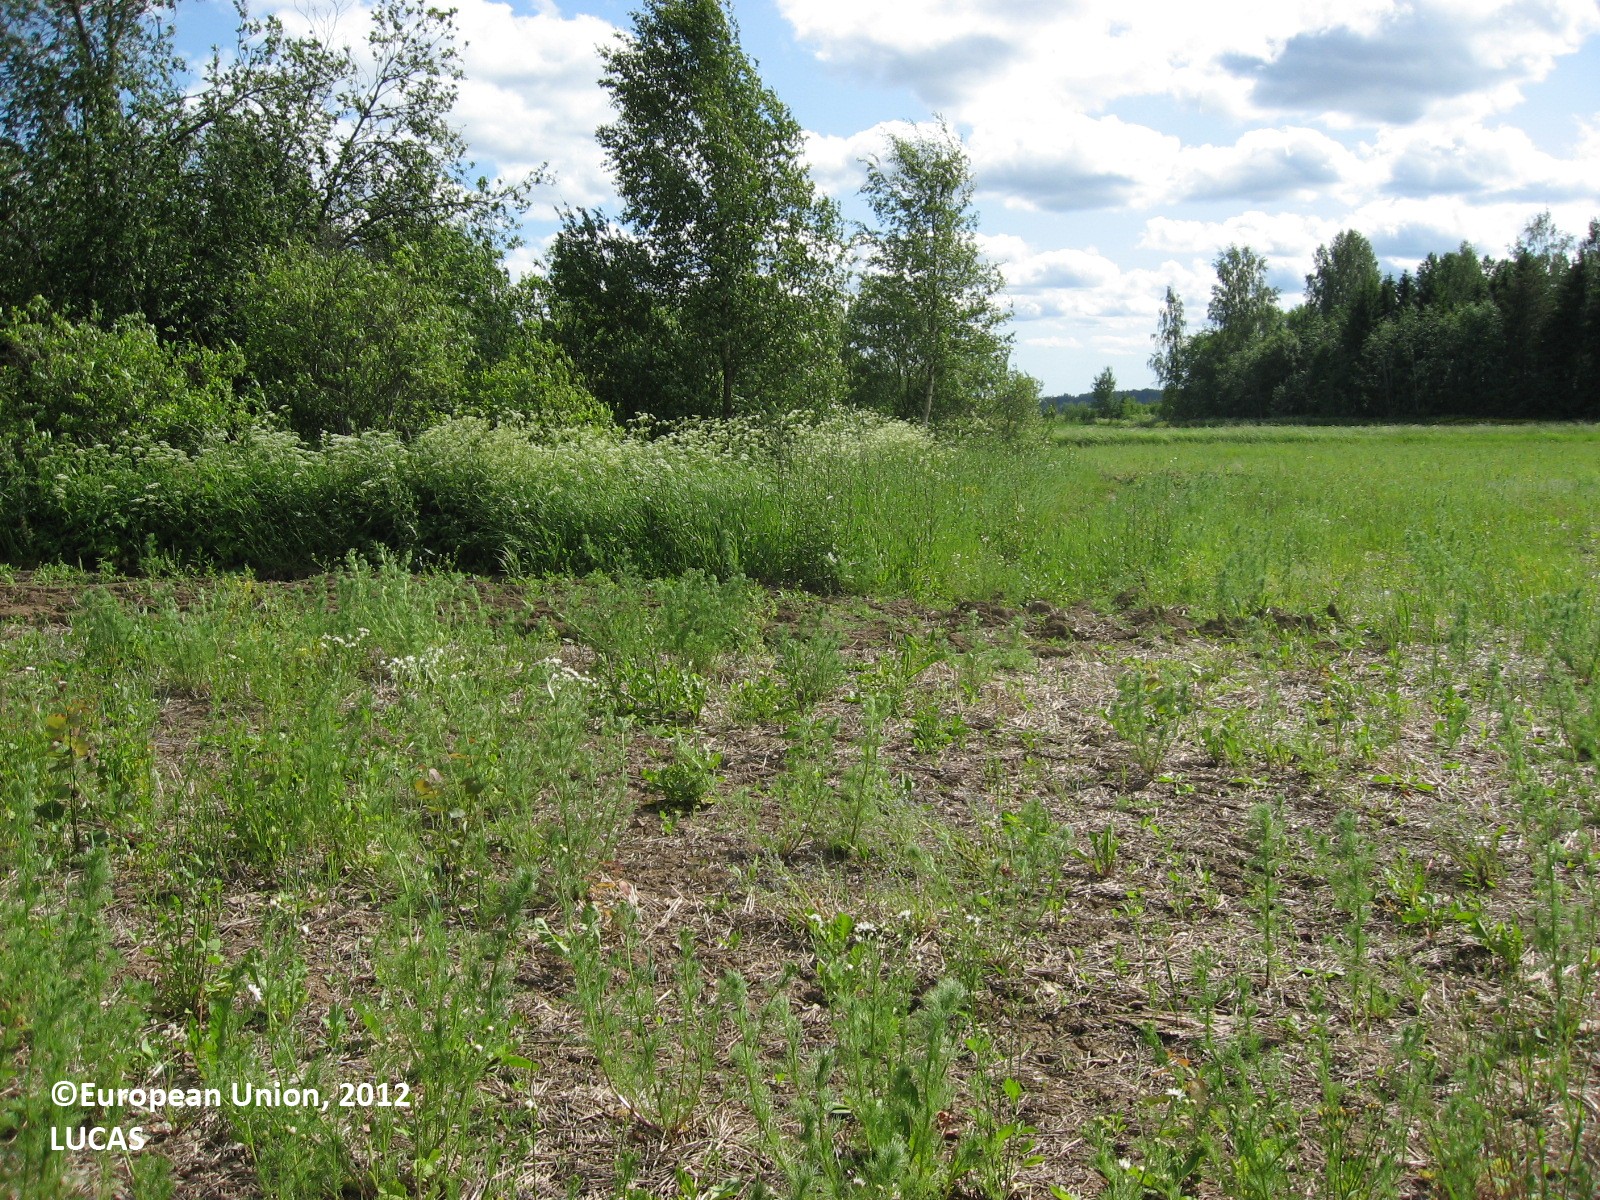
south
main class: Grassland
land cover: Spontaneously vegetated surfaces
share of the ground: 25 - 50 %
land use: Fallow land
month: June
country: FI
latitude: 60.6054
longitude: 26.4647
